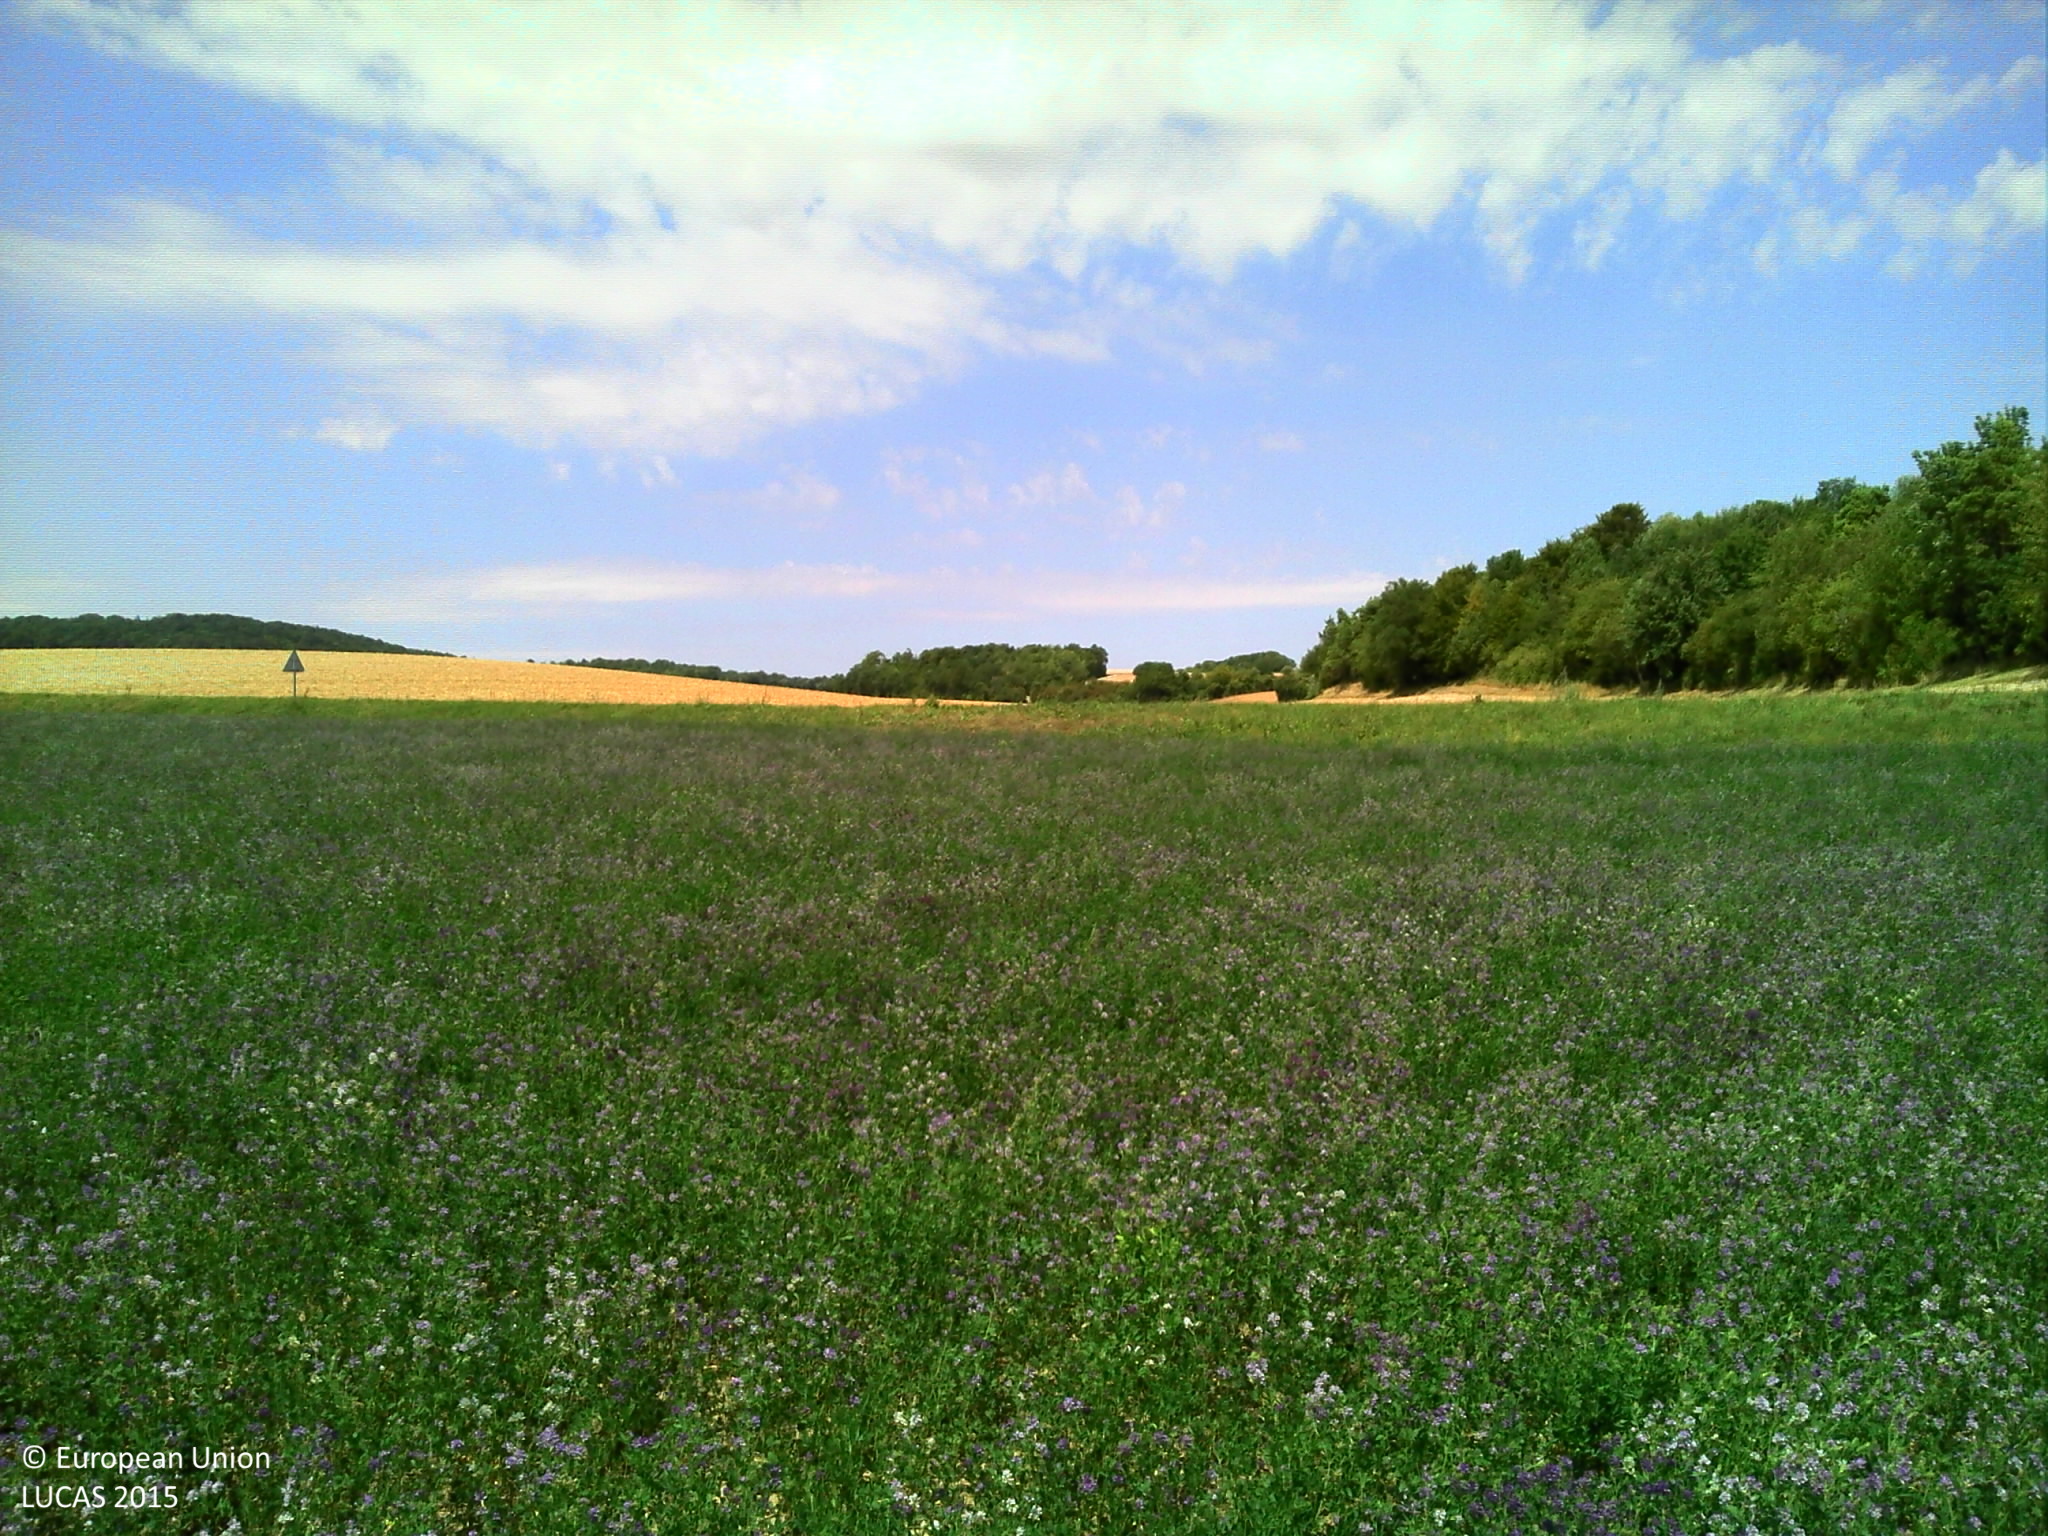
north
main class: Cropland
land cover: Lucerne
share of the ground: > 75 %
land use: Agriculture (excluding fallow land and kitchen gardens)
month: August
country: FR
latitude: 49.0991
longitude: 4.2022
